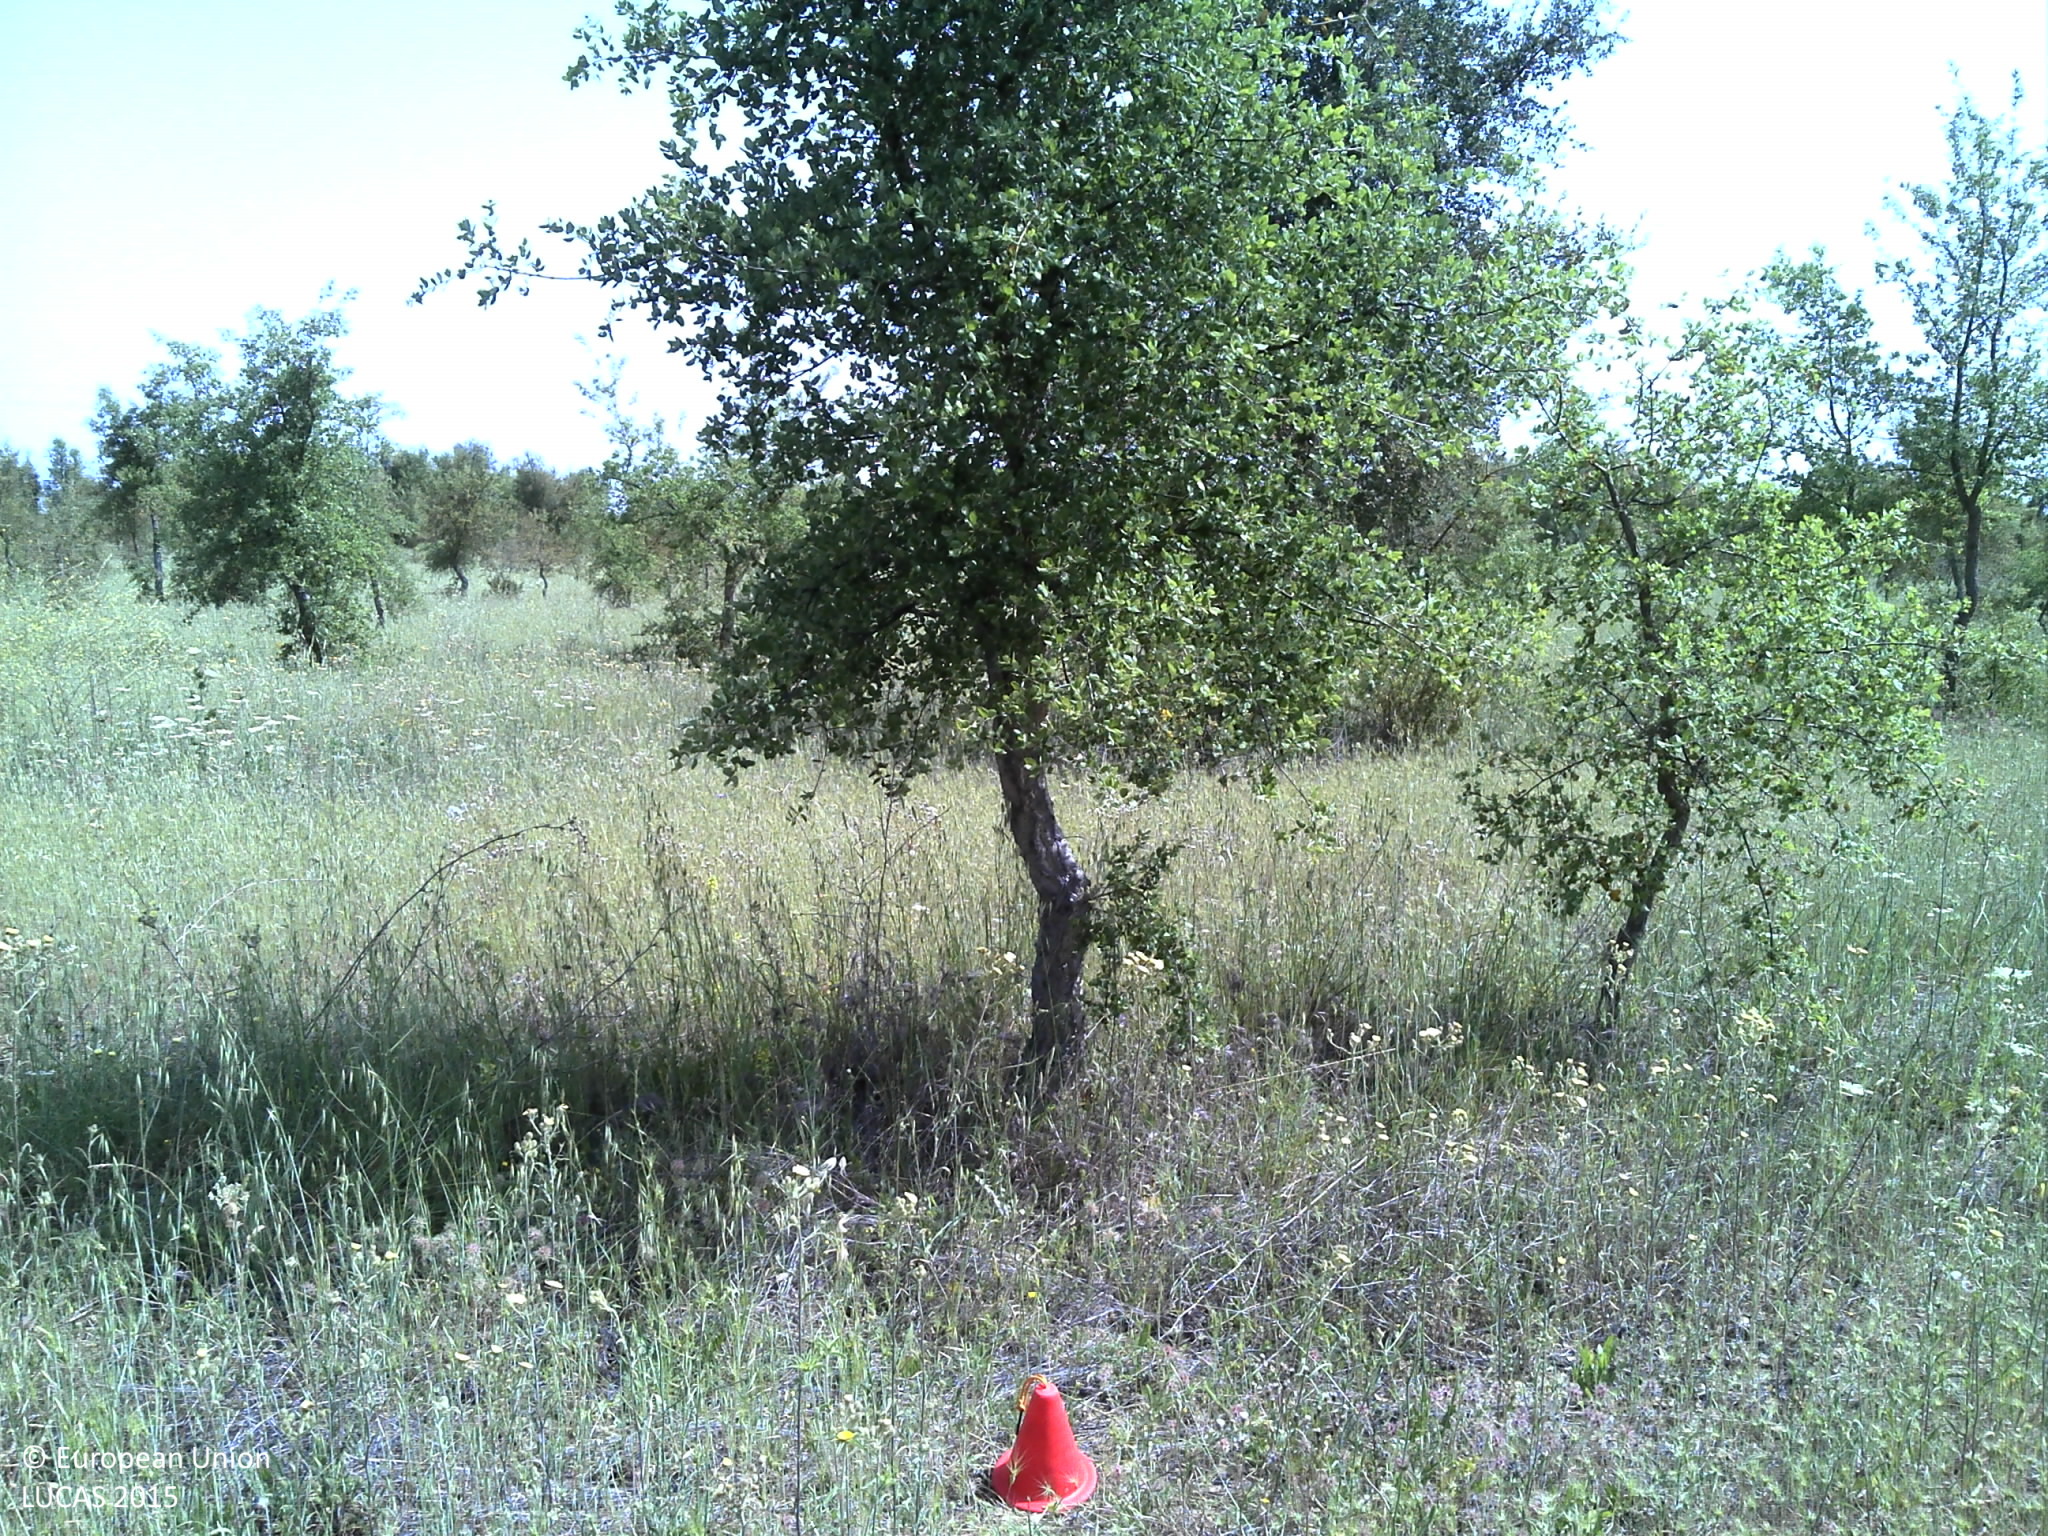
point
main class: Woodland
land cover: Broadleaved woodland
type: broadleaved evergreen forest
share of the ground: 10 - 25 %
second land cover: Grassland without tree/shrub cover
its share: 25 - 50 %
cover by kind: herbaceous plants 40 %, unconsolidated bare surface 40 %, broadleaved forest trees 20 %
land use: Forestry
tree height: < 5 m
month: May
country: PT
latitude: 38.9566
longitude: -7.8038
